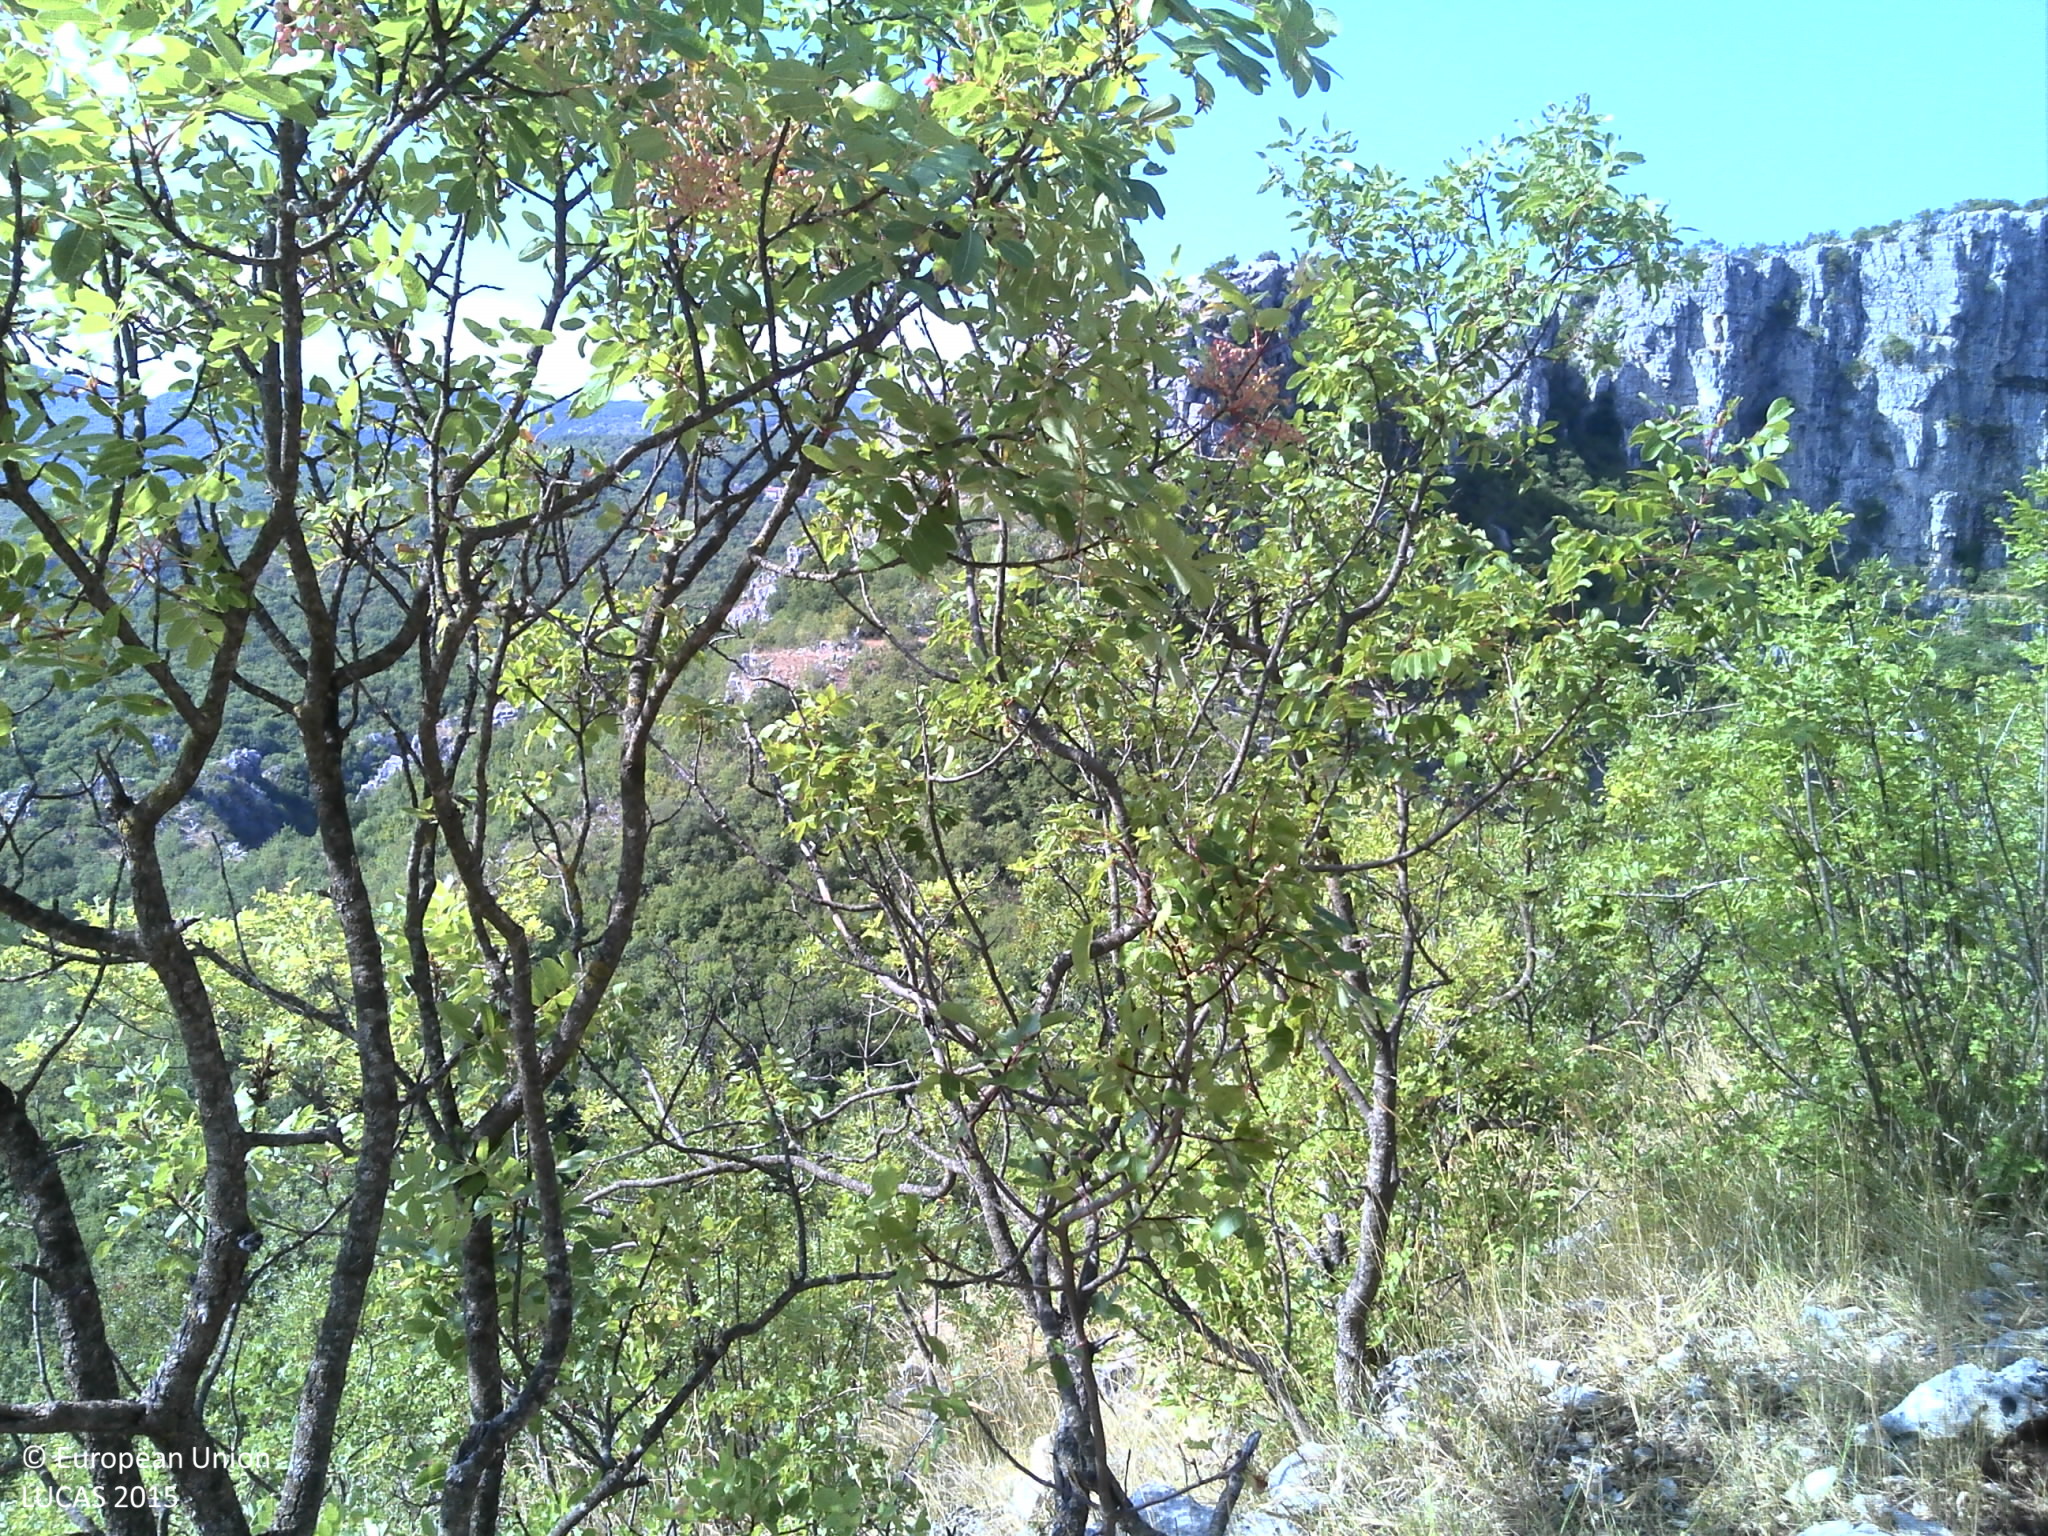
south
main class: Shrubland
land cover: Shrubland with sparse tree cover
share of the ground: 50 - 75 %
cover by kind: shrubs 60 %, consolidated bare surface 15 %, herbaceous plants 10 %, unconsolidated bare surface 10 %, broadleaved forest trees 5 %
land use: Semi-natural and natural areas not in use
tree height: < 5 m
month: July
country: HR
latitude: 43.4735
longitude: 17.1000
